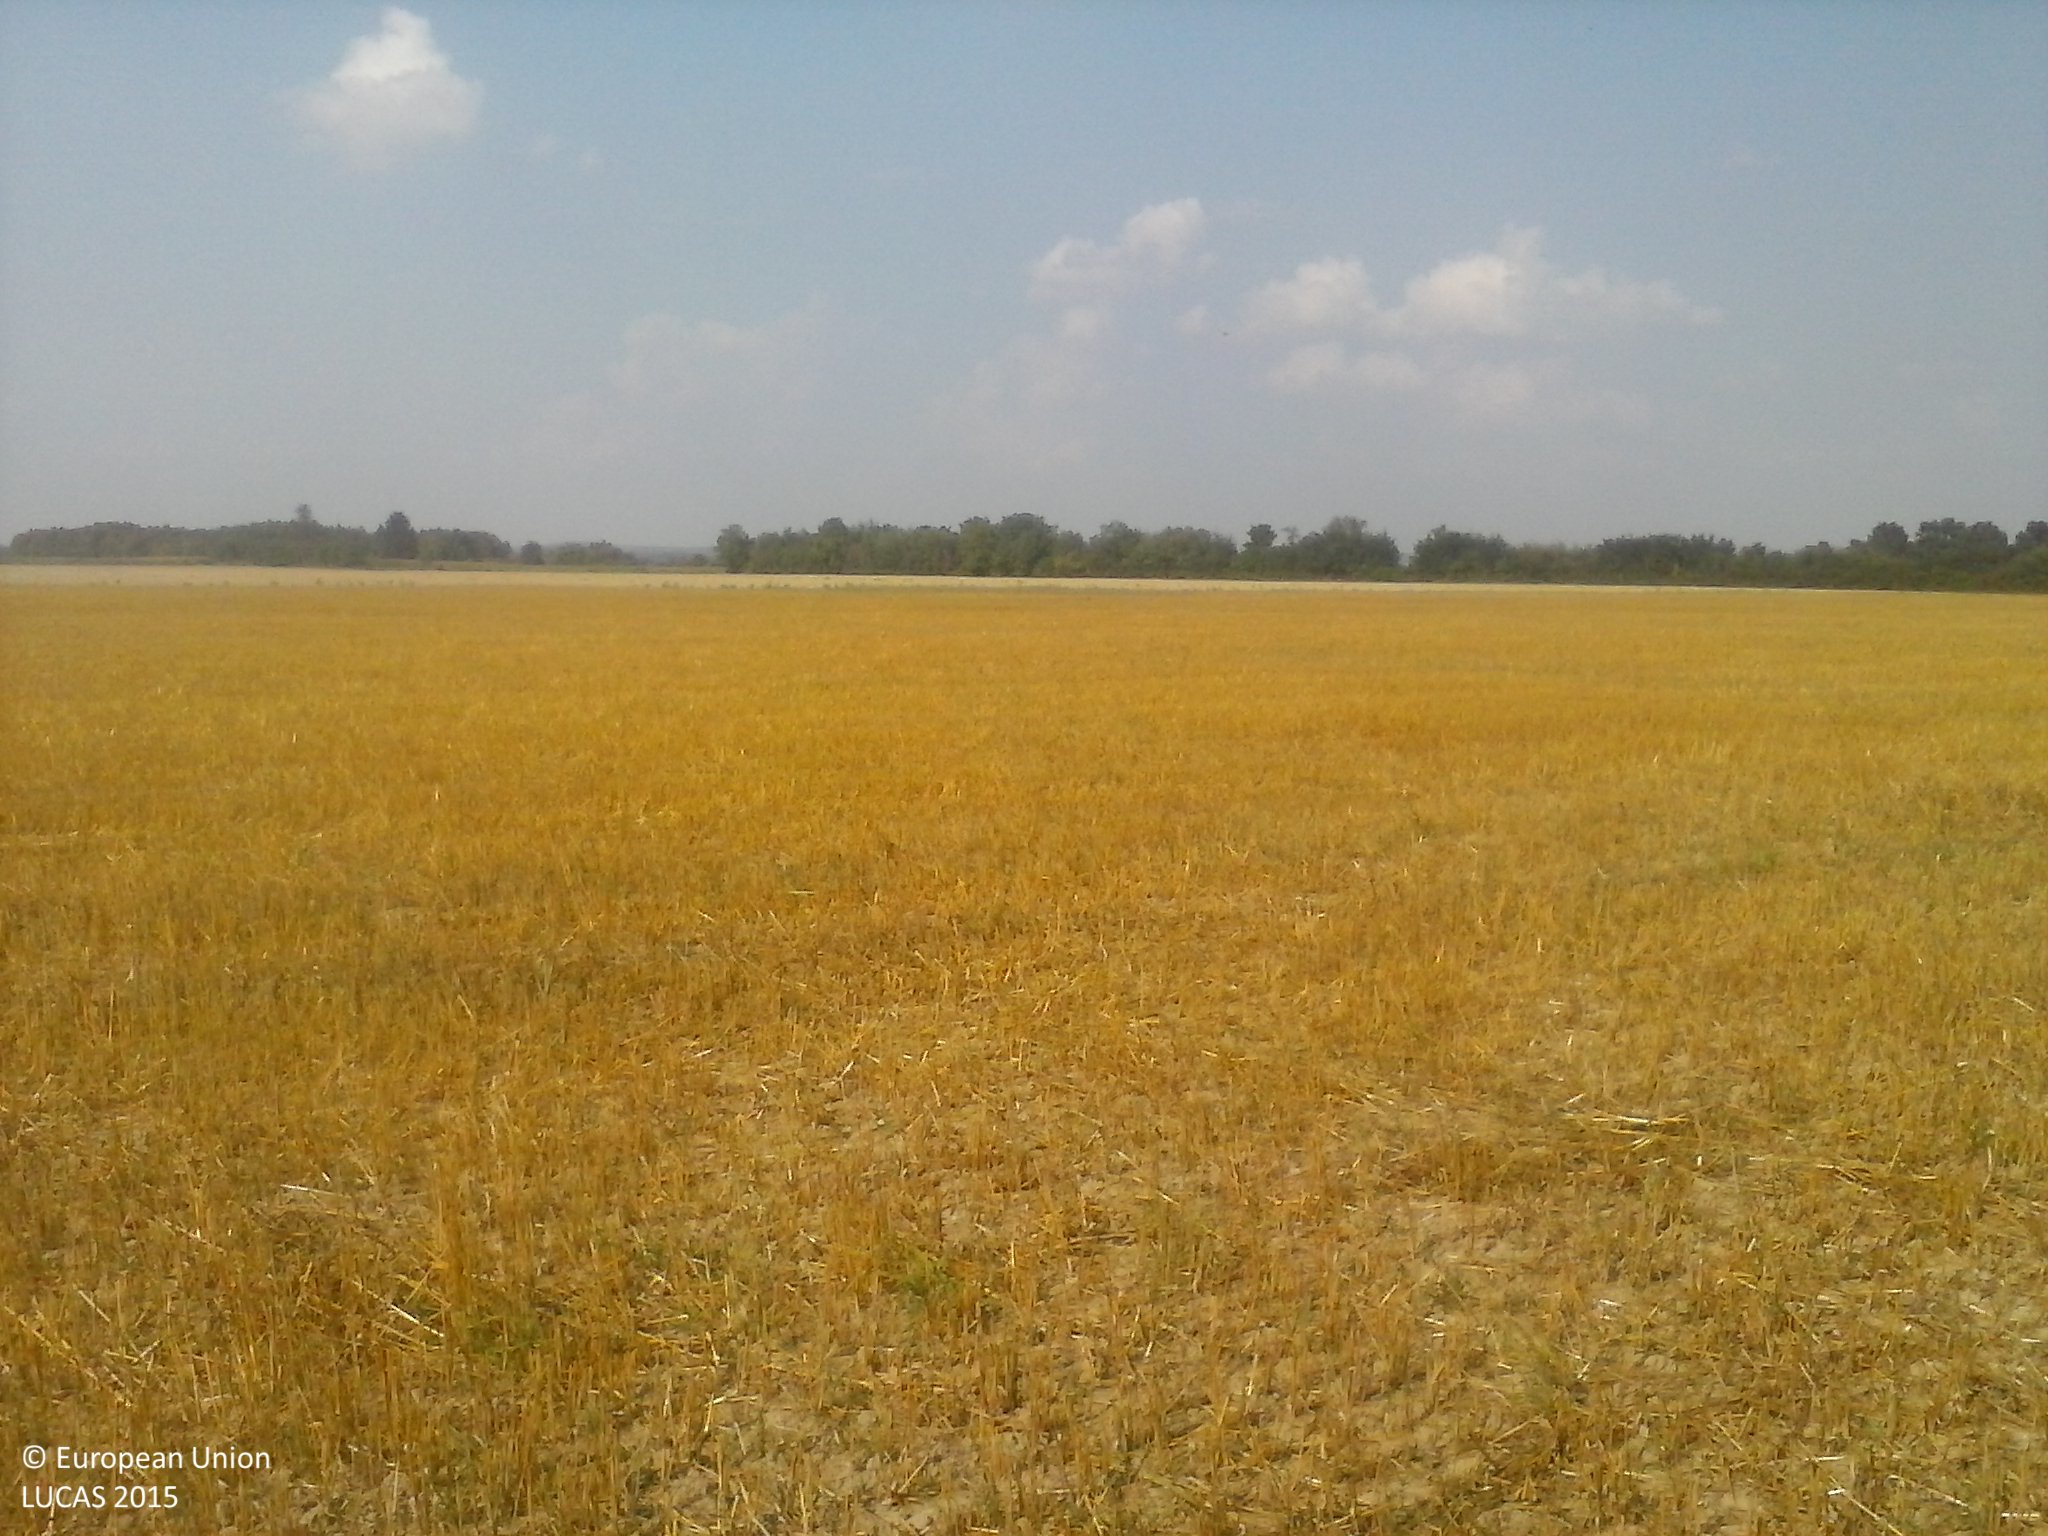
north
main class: Cropland
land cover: Oats
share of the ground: > 75 %
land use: Agriculture (excluding fallow land and kitchen gardens)
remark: Harvested field
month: August
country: HU
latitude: 46.0124
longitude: 17.7926
